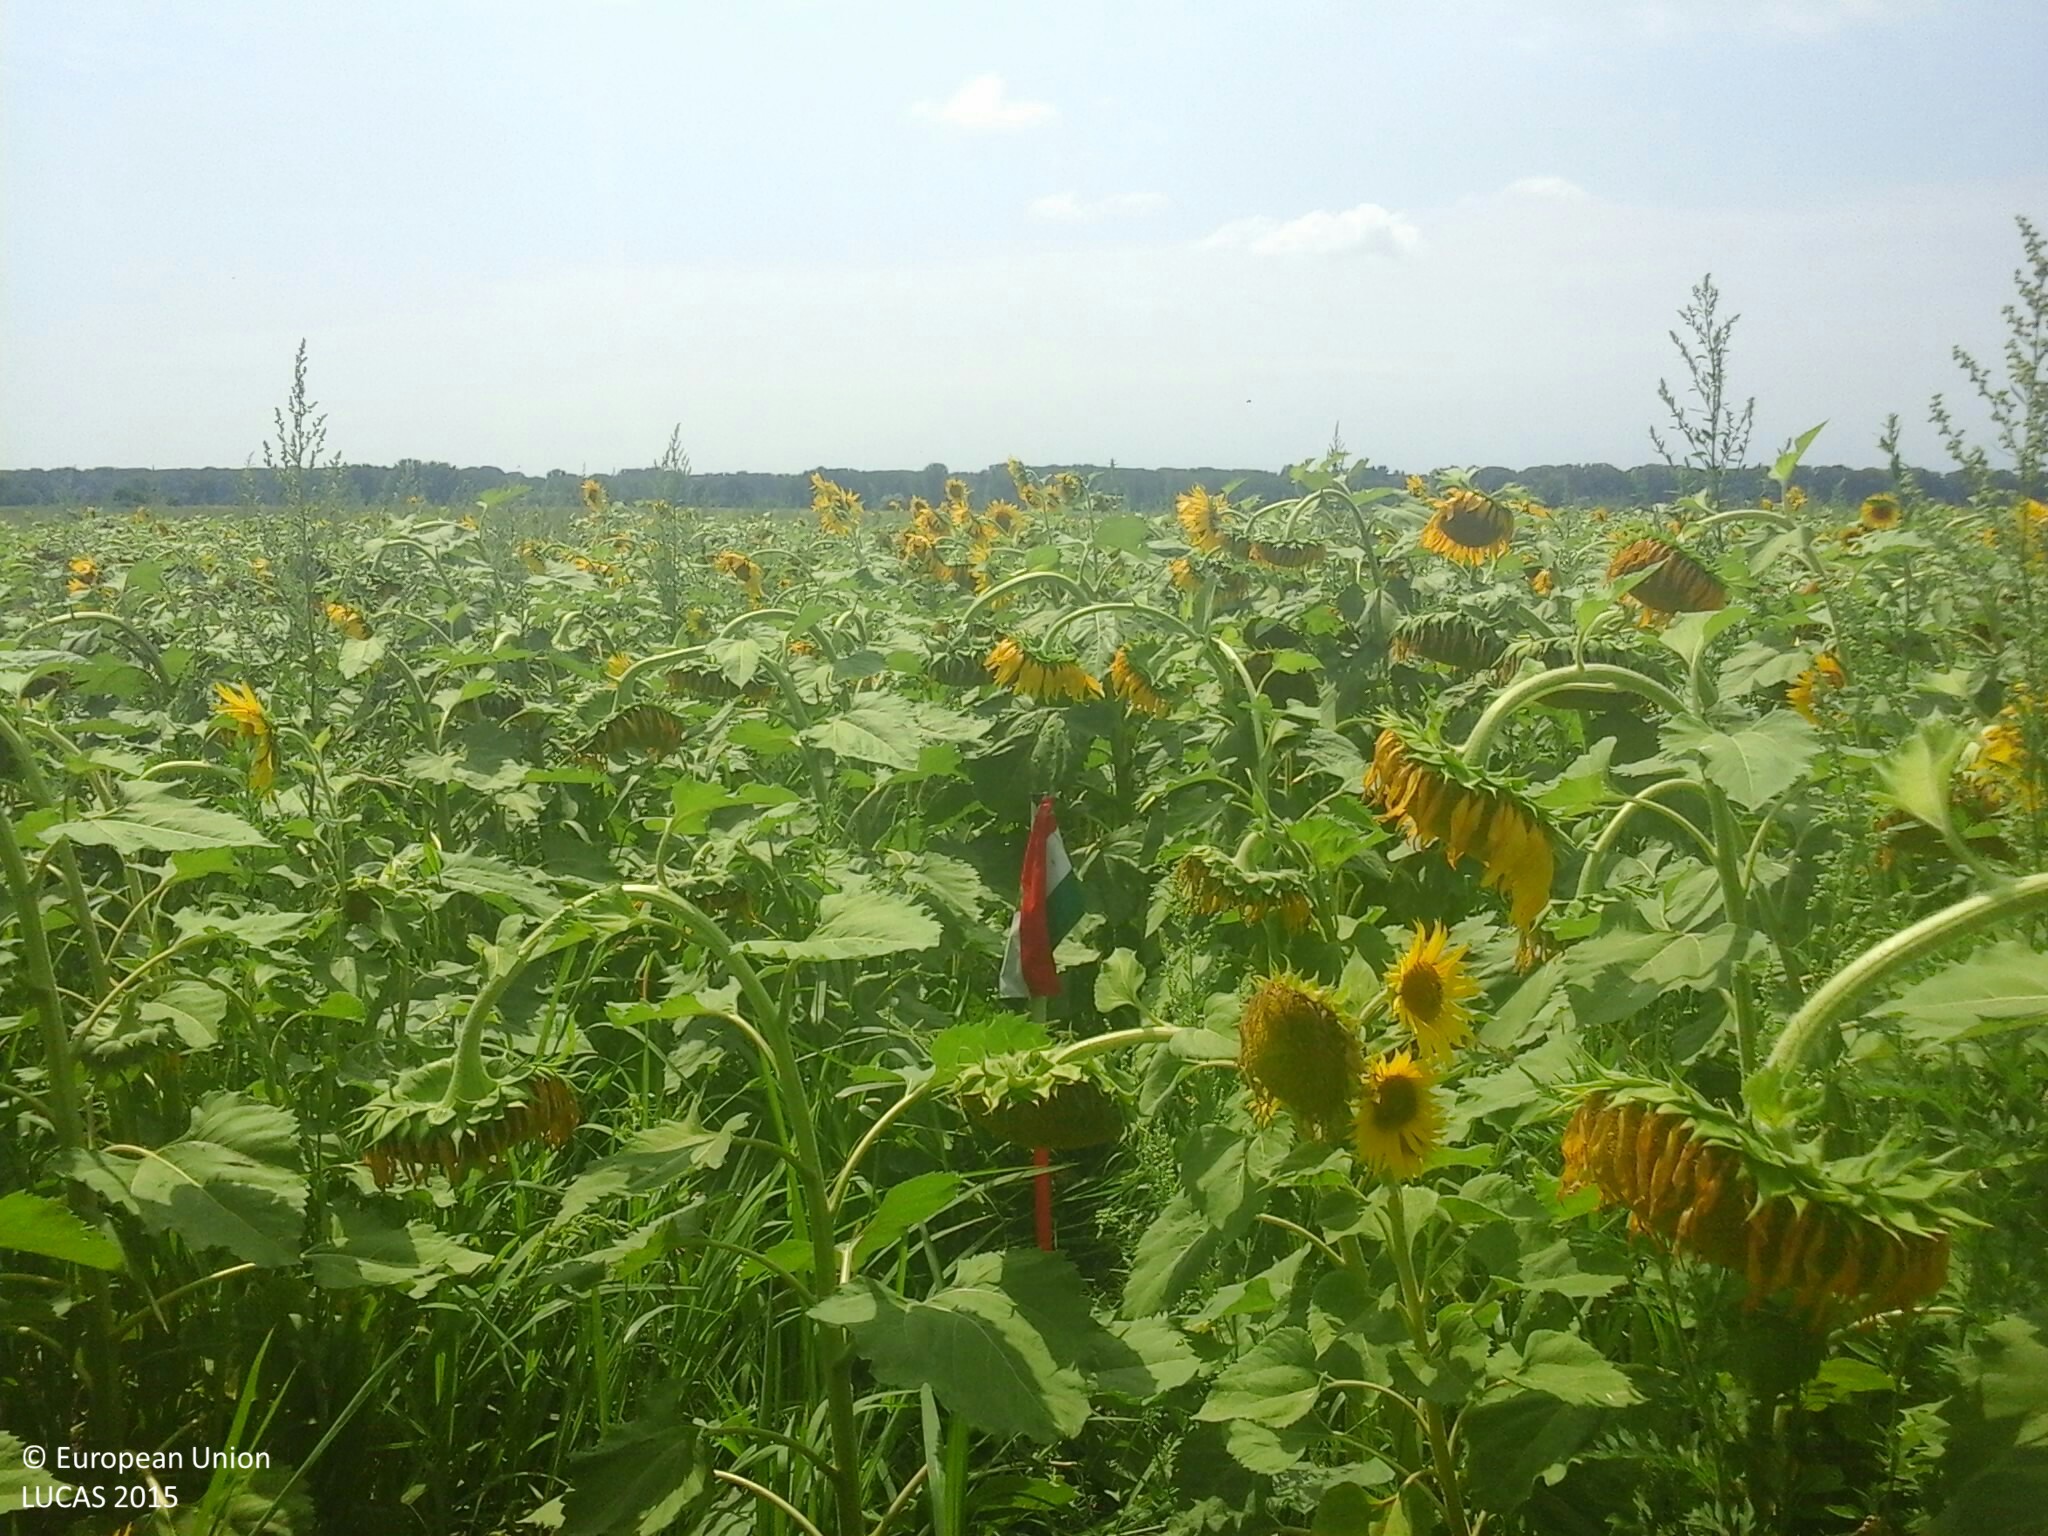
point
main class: Cropland
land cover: Sunflower
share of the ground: > 75 %
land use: Agriculture (excluding fallow land and kitchen gardens)
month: July
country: HU
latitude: 46.7974
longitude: 20.0992
